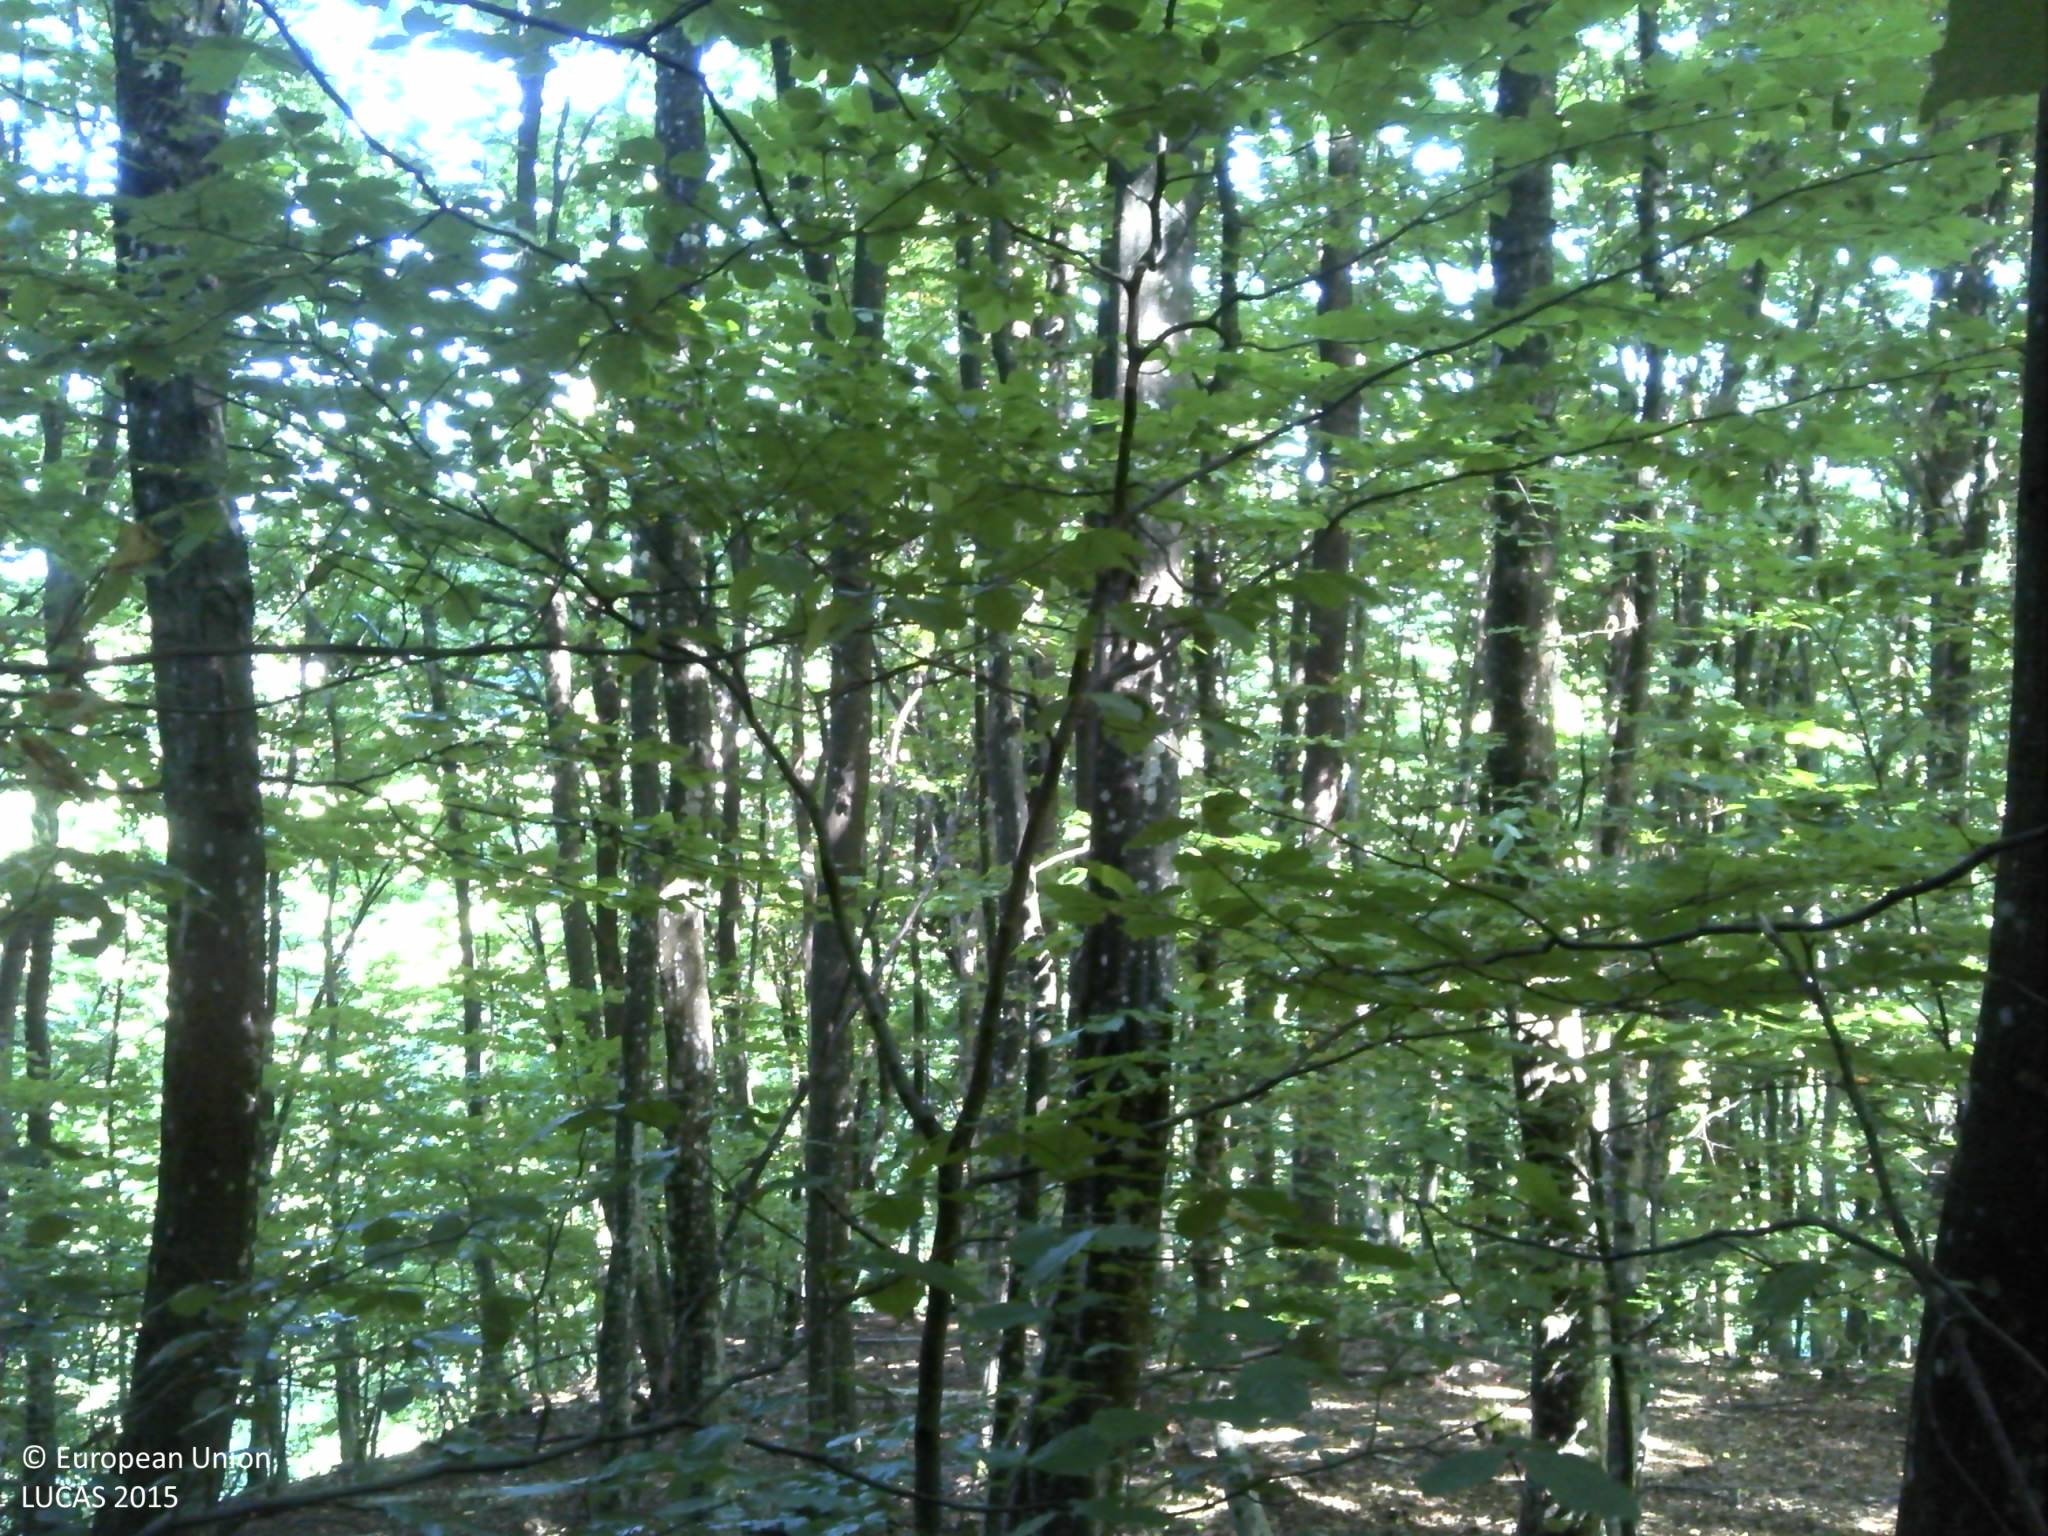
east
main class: Woodland
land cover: Broadleaved woodland
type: beech forest
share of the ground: > 75 %
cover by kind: broadleaved forest trees 100 %
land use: Forestry
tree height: > 5 m
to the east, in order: Broadleaved woodland; Rivers and streams; Fences; Grassland without tree/shrub cover; Other fresh vegetables; Artificial constructions in urban areas; Grass margins; Grassland without tree/shrub cover; Shrubland without tree cover
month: August
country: HR
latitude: 45.3144
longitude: 15.6978
